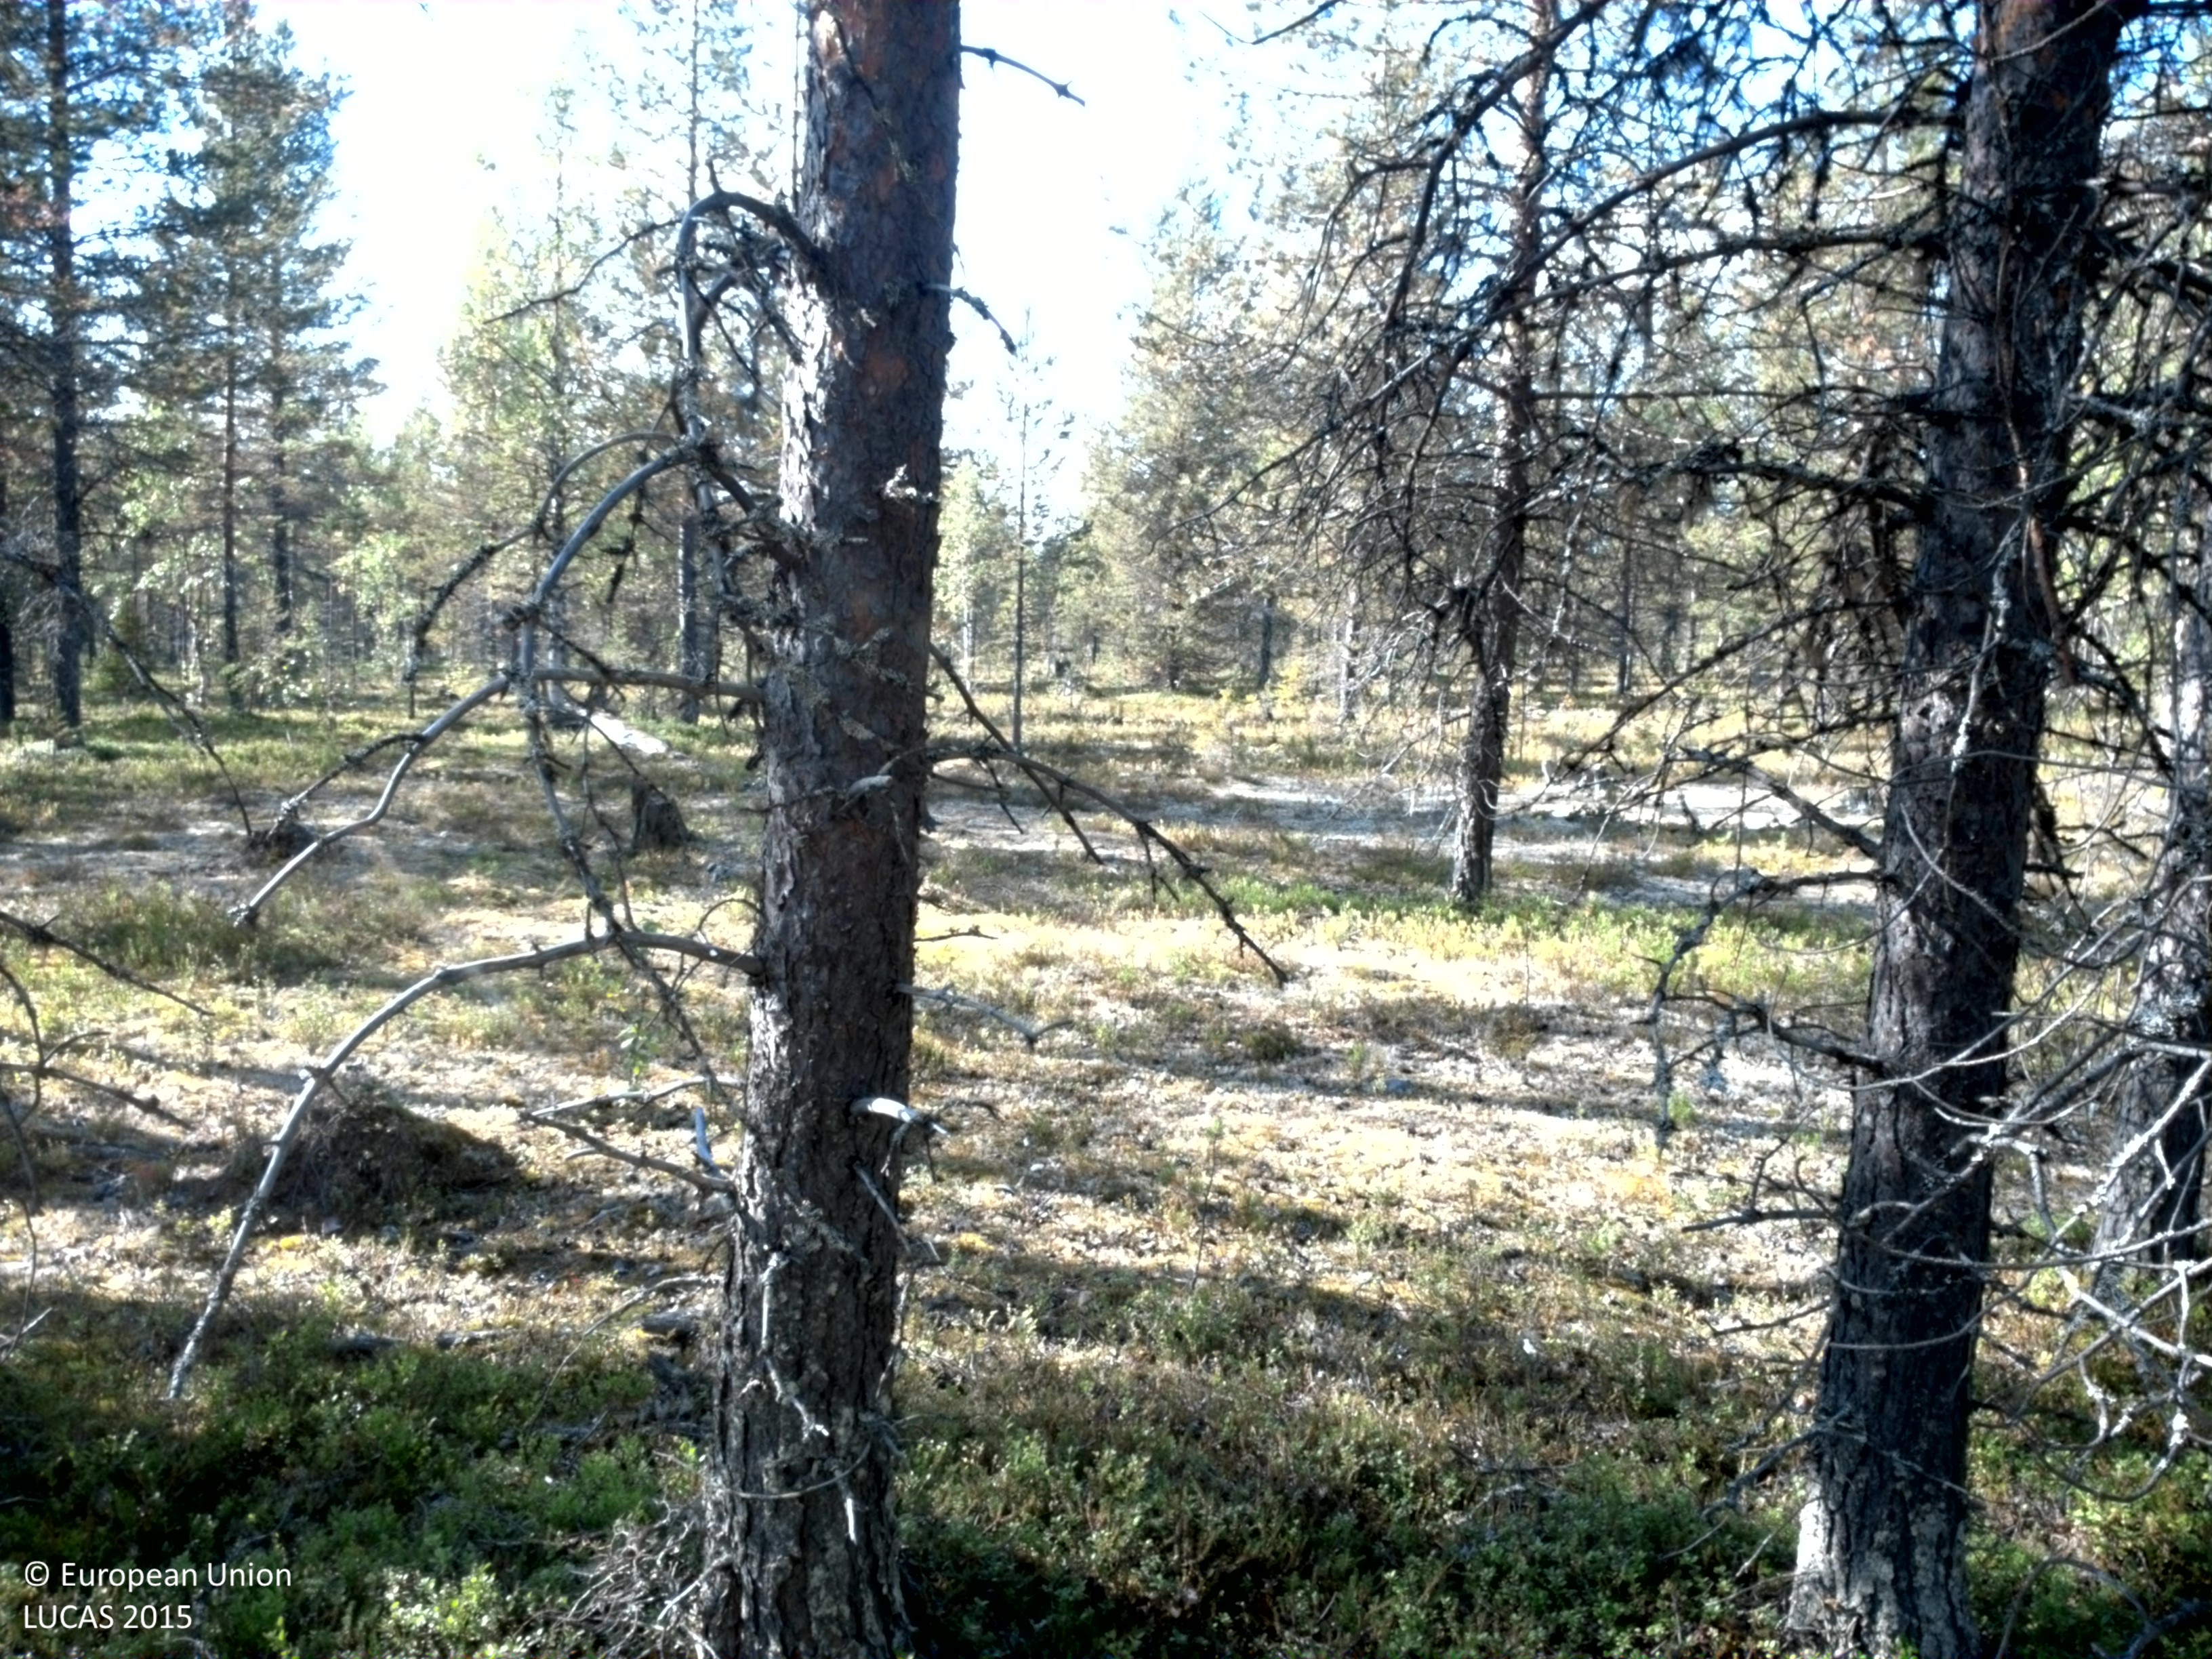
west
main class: Woodland
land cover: Pine dominated coniferous woodland
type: boreal forest
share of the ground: 10 - 25 %
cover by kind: shrubs 60 %, coniferous forest trees 20 %, lichens and mosses 15 %, broadleaved forest trees 5 %
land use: Forestry
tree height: > 5 m
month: August
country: SE
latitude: 66.8309
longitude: 20.7268
